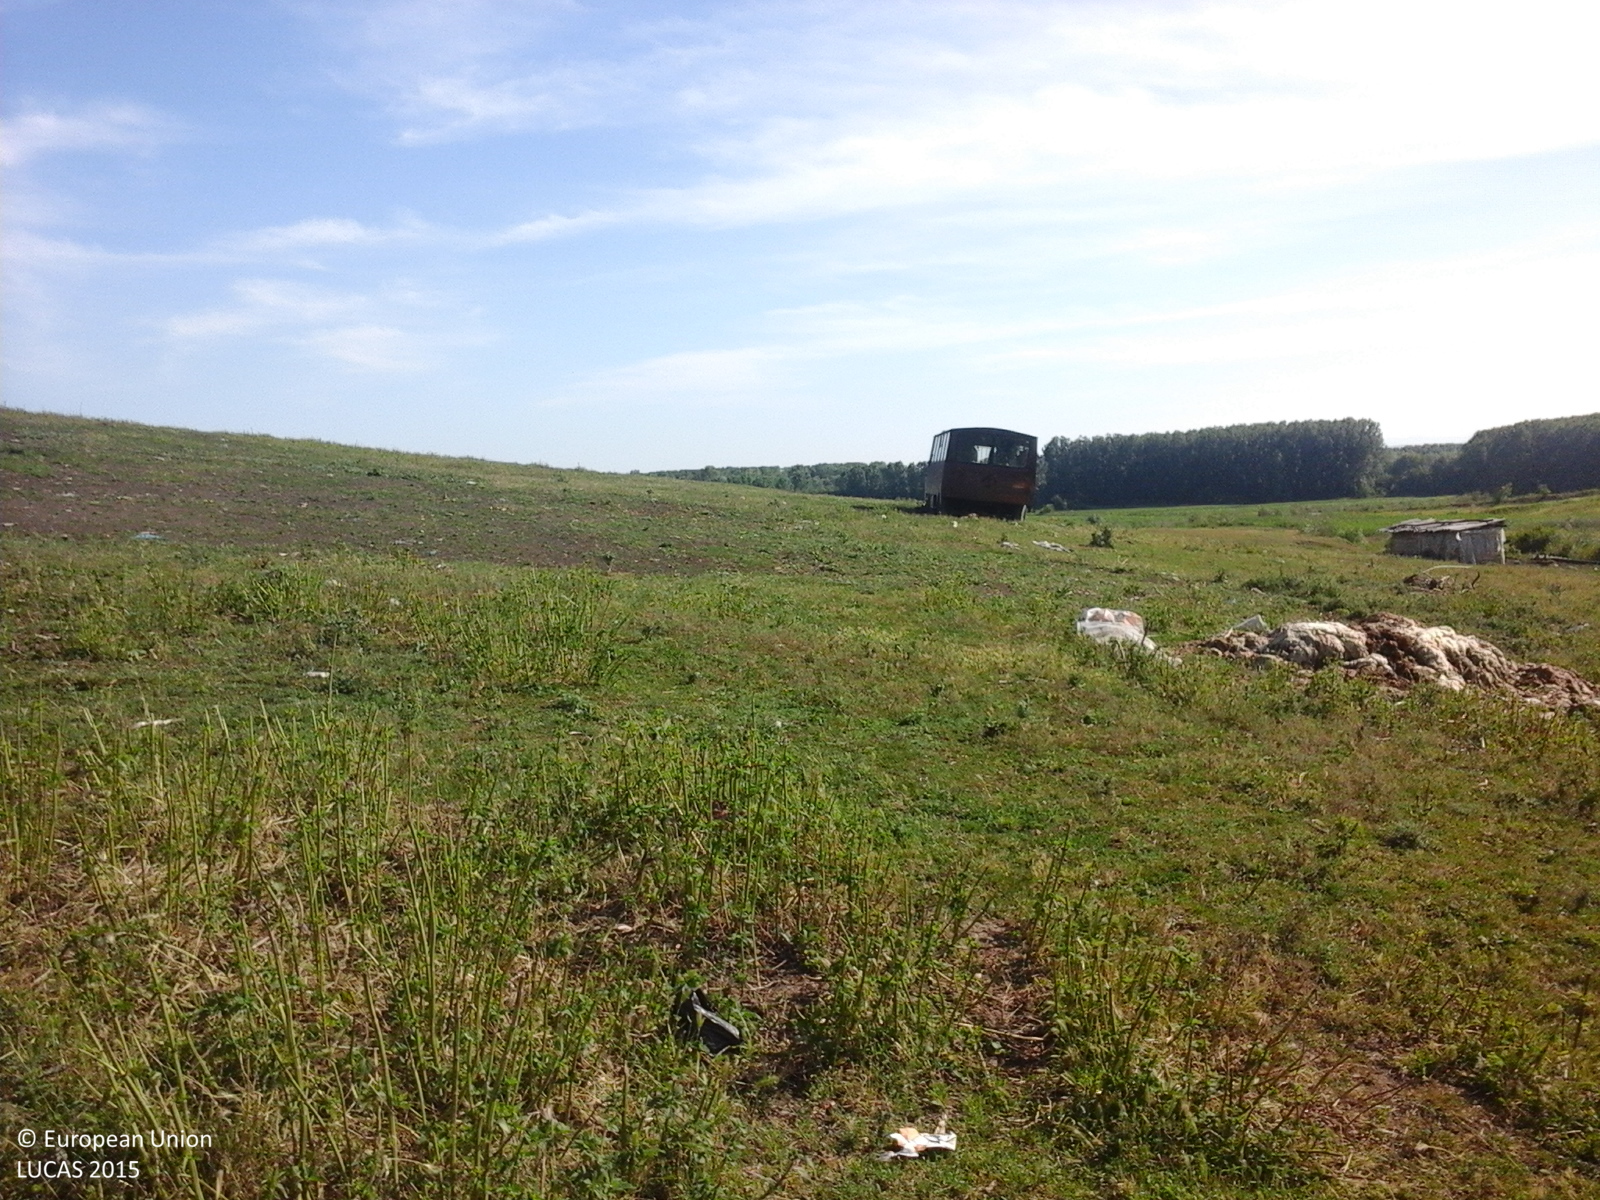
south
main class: Grassland
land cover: Grassland without tree/shrub cover
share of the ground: > 75 %
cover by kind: herbaceous plants 100 %
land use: Agriculture (excluding fallow land and kitchen gardens)
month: June
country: RO
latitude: 47.0868
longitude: 26.9191
